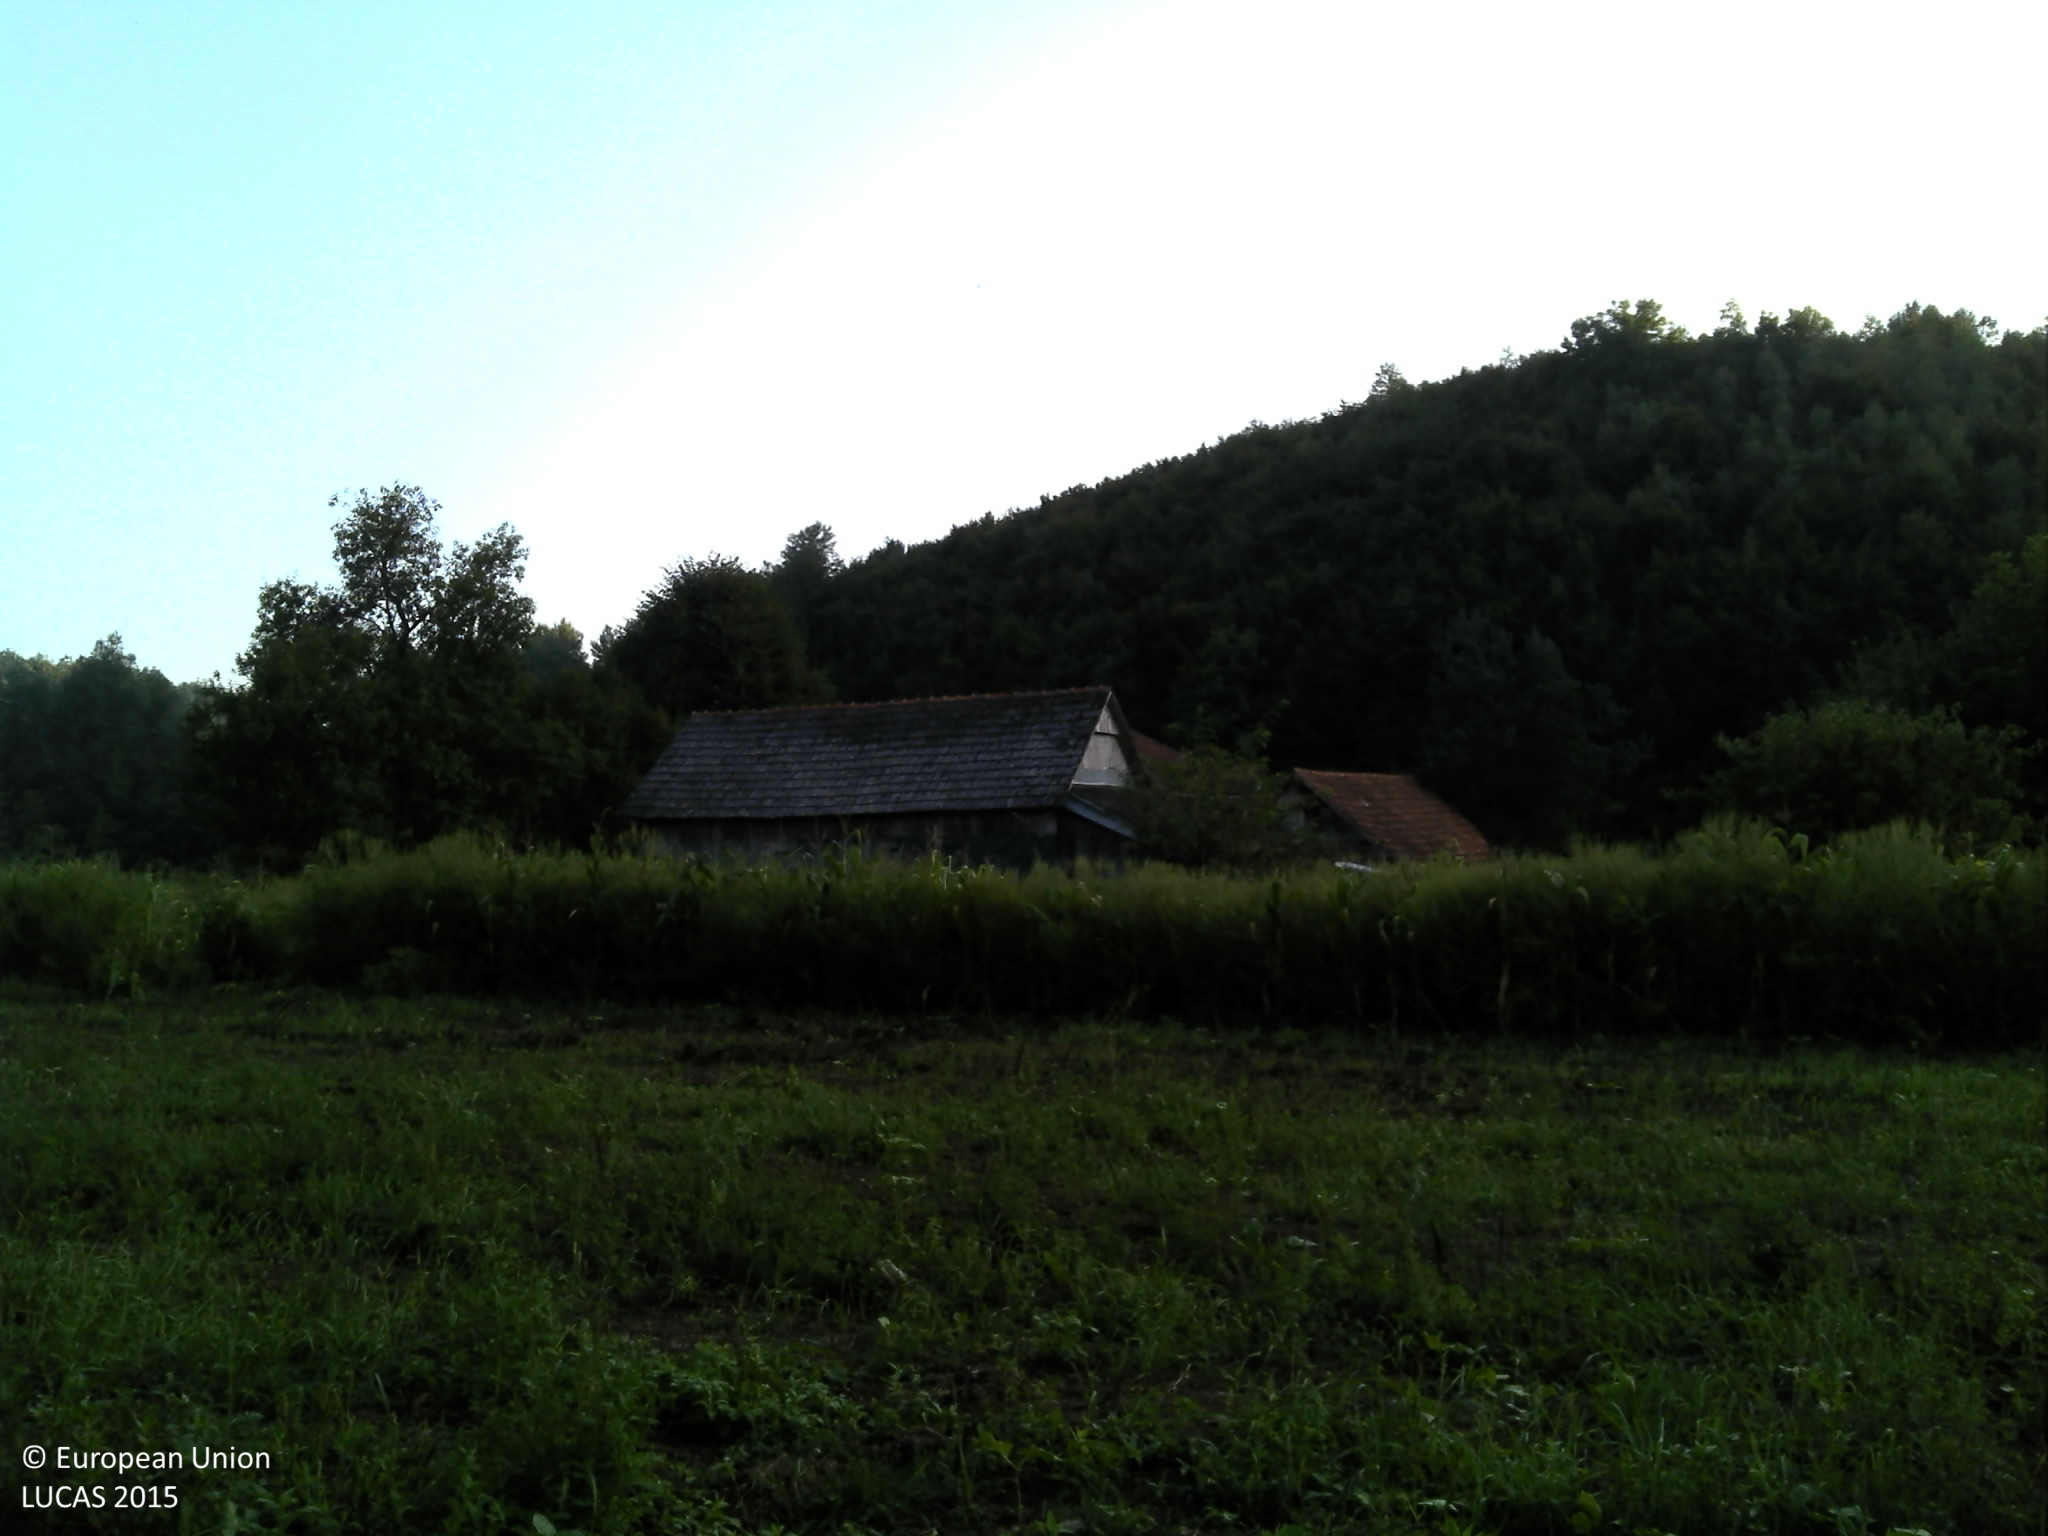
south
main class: Grassland
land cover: Grassland with sparse tree/shrub cover
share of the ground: > 75 %
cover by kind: herbaceous plants 90 %, broadleaved forest trees 5 %, shrubs 5 %
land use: Residential
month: August
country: HR
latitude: 45.2605
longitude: 15.6923
